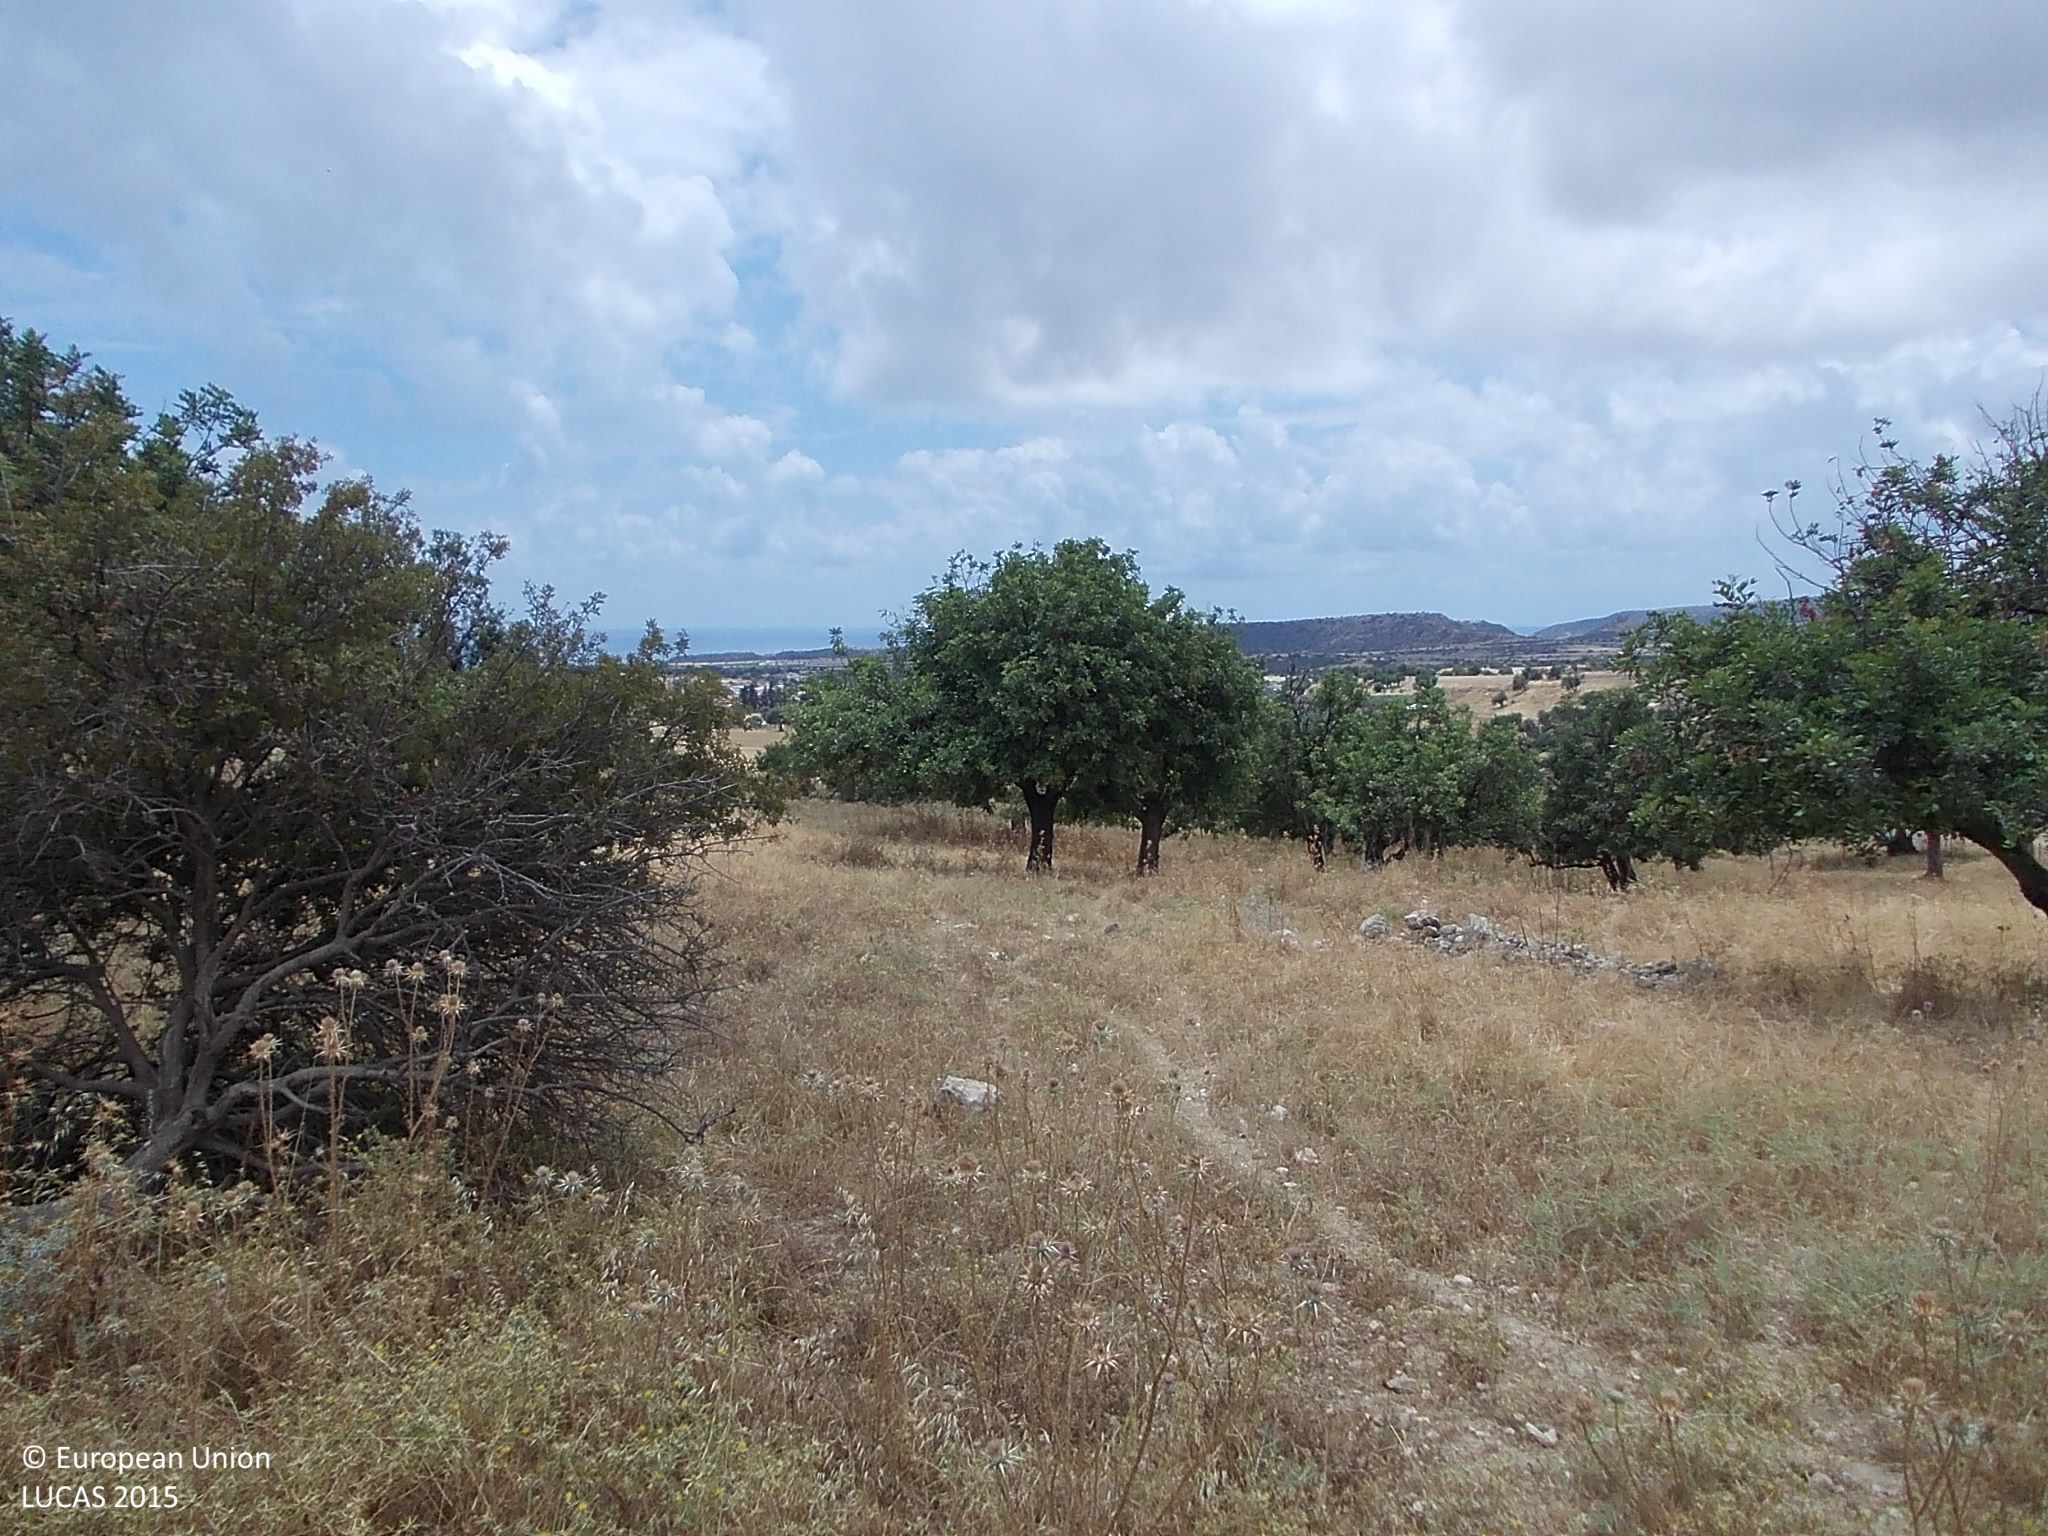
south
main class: Cropland
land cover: Permanent industrial crops
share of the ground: 10 - 25 %
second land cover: Spontaneously vegetated surfaces
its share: > 75 %
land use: Agriculture (excluding fallow land and kitchen gardens)
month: May
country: CY
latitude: 34.7037
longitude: 32.7652
